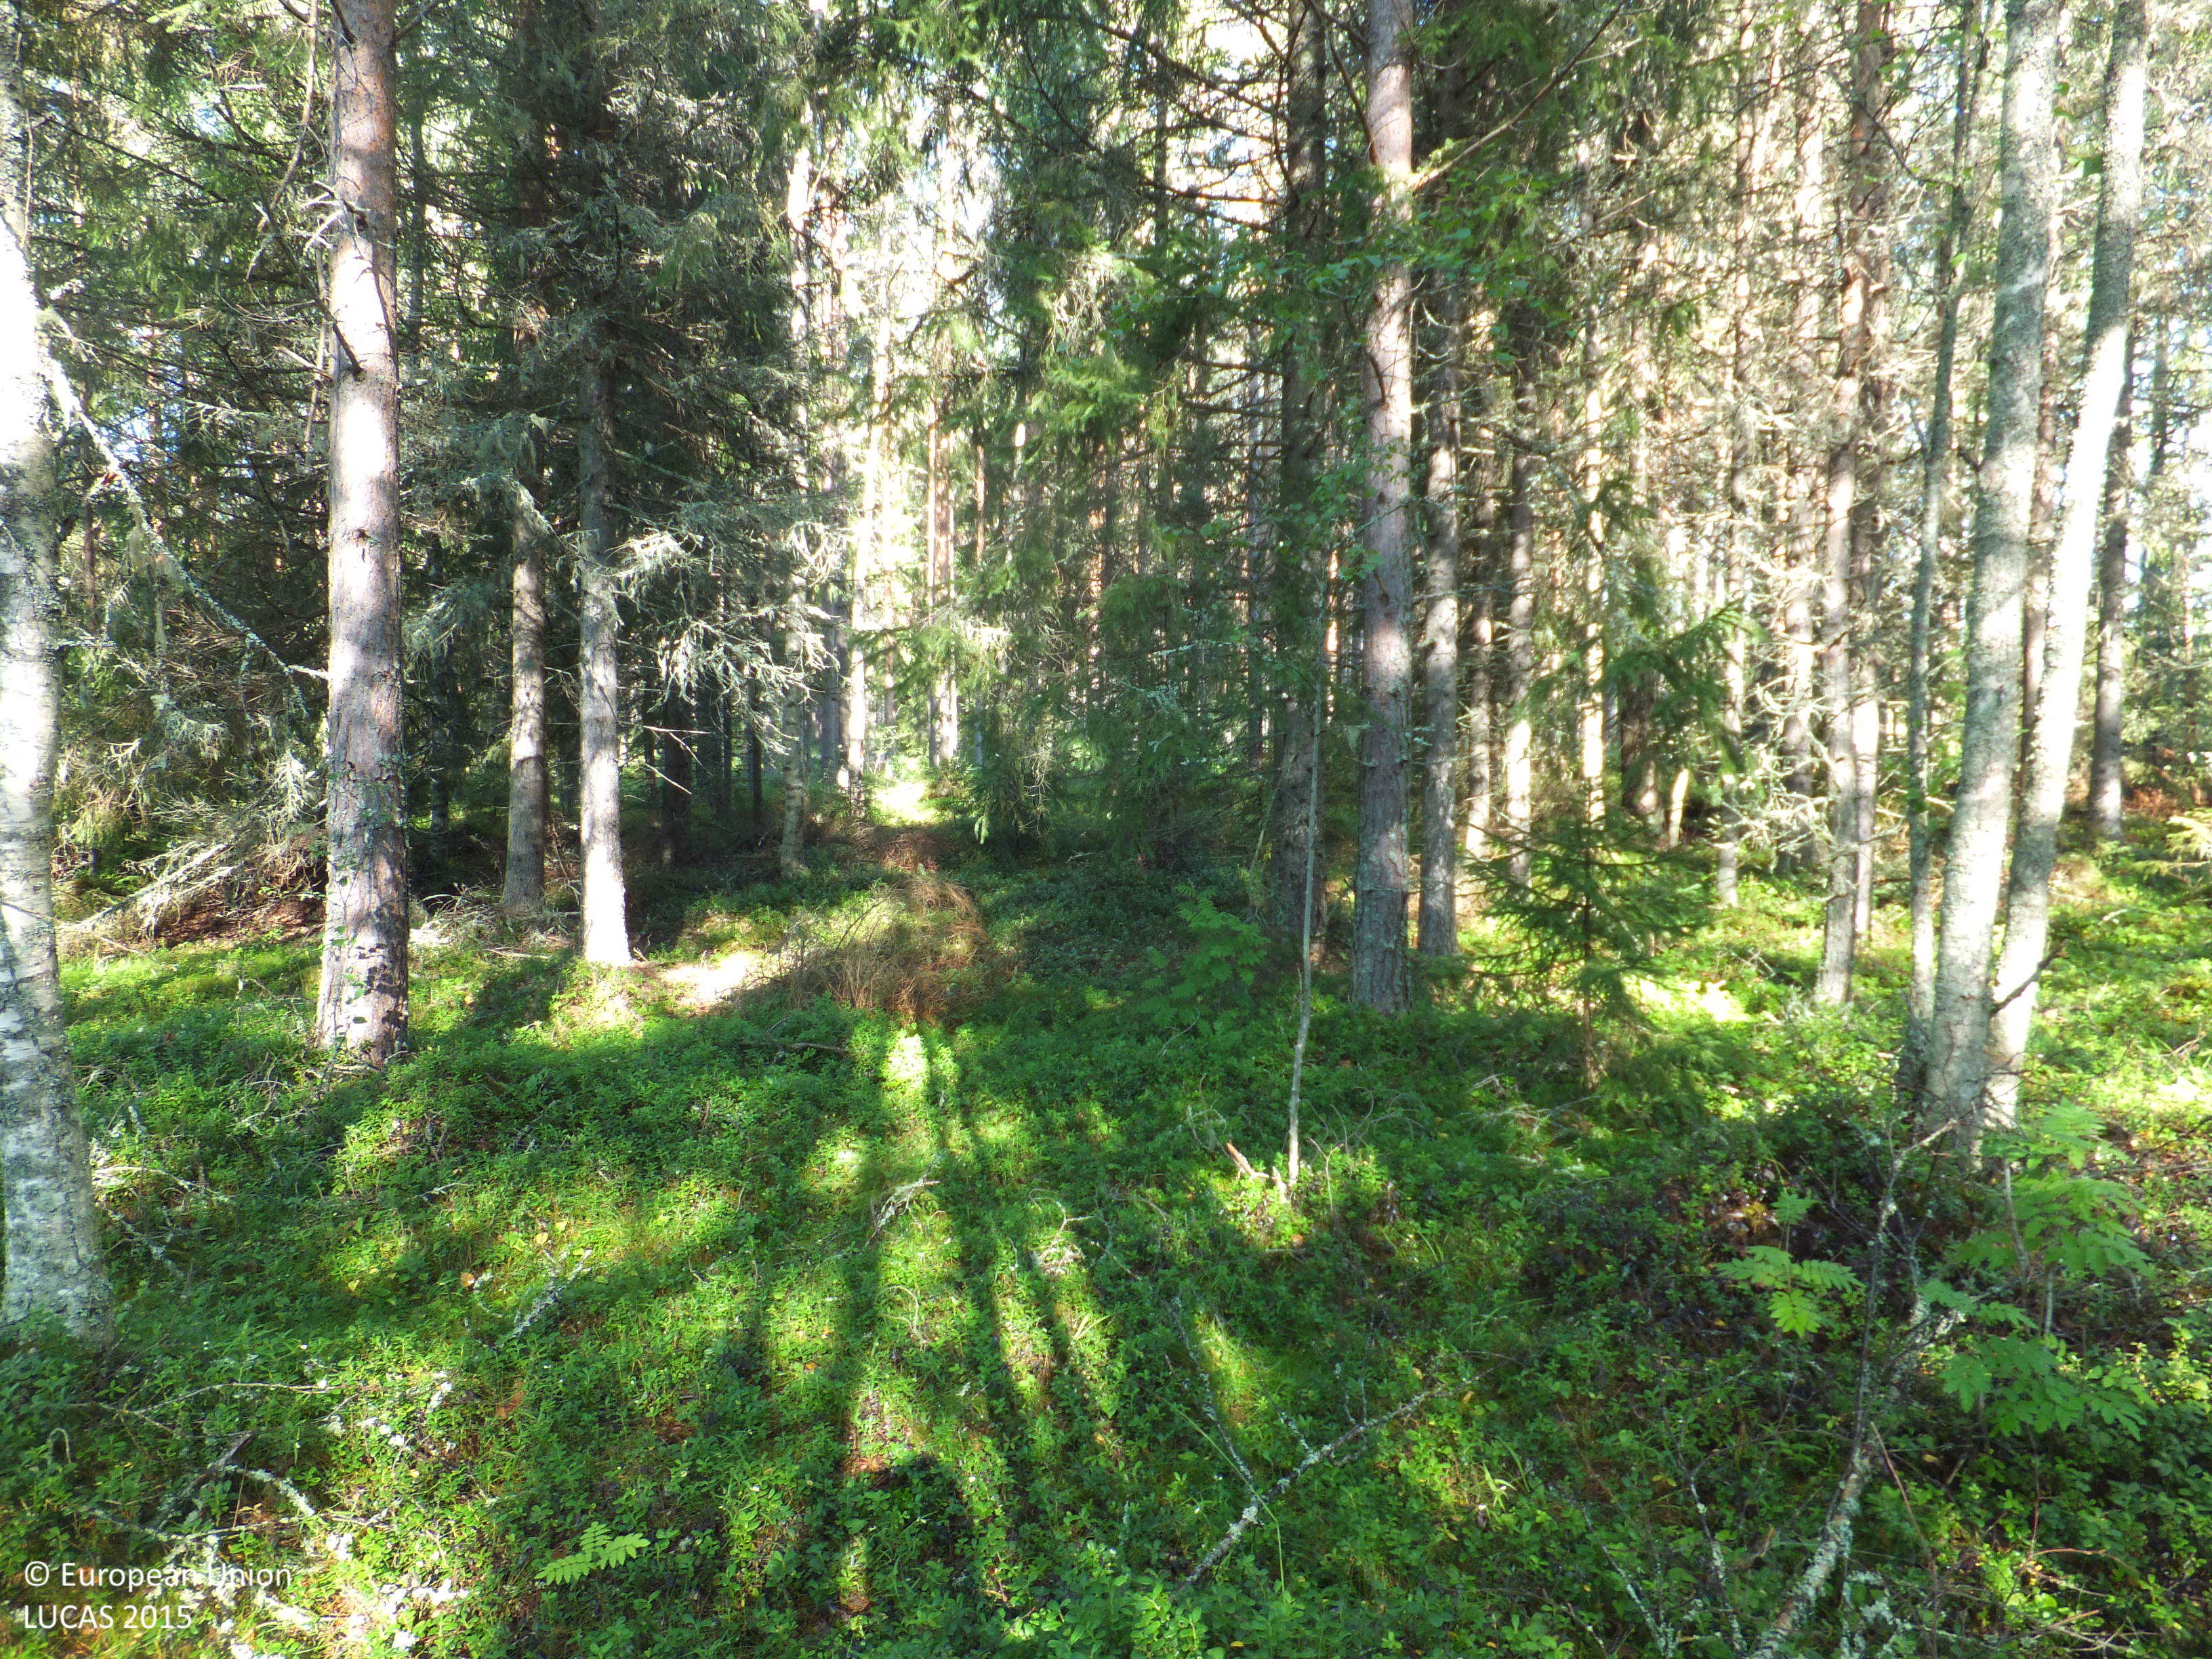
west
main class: Woodland
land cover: Broadleaved woodland
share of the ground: 50 - 75 %
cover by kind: broadleaved forest trees 60 %, shrubs 15 %, herbaceous plants 10 %, lichens and mosses 10 %, coniferous forest trees 5 %
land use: Forestry
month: August
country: FI
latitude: 63.1503
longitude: 22.0512
